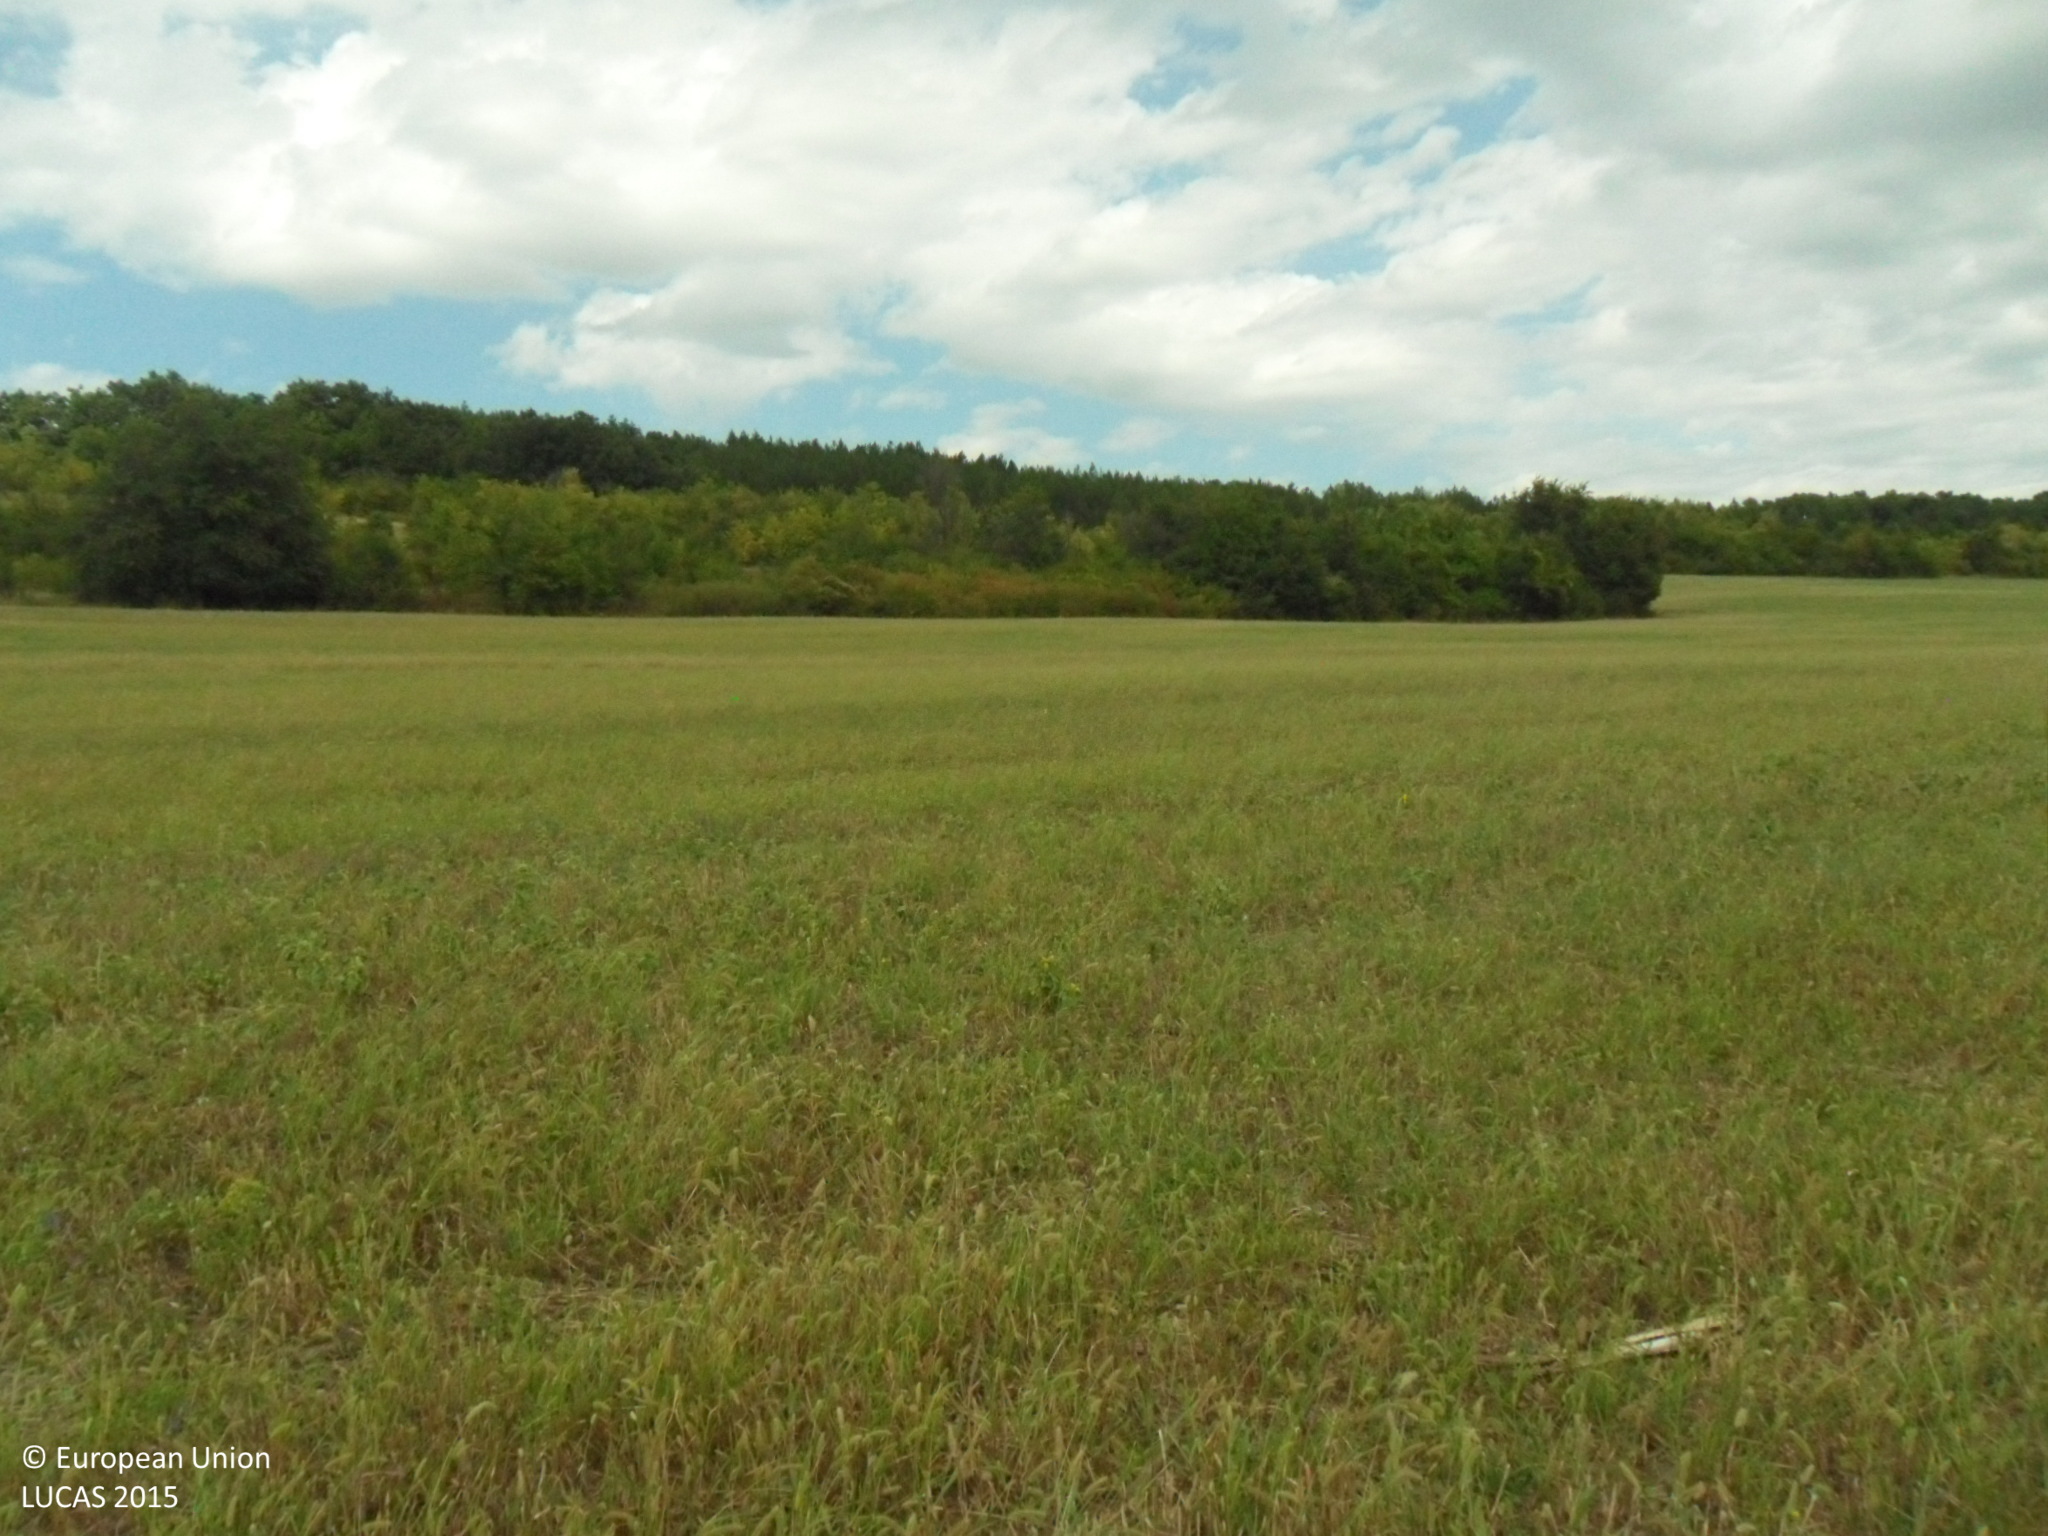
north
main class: Cropland
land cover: Common wheat
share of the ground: > 75 %
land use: Agriculture (excluding fallow land and kitchen gardens)
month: September
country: BG
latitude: 43.5567
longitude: 26.3555
